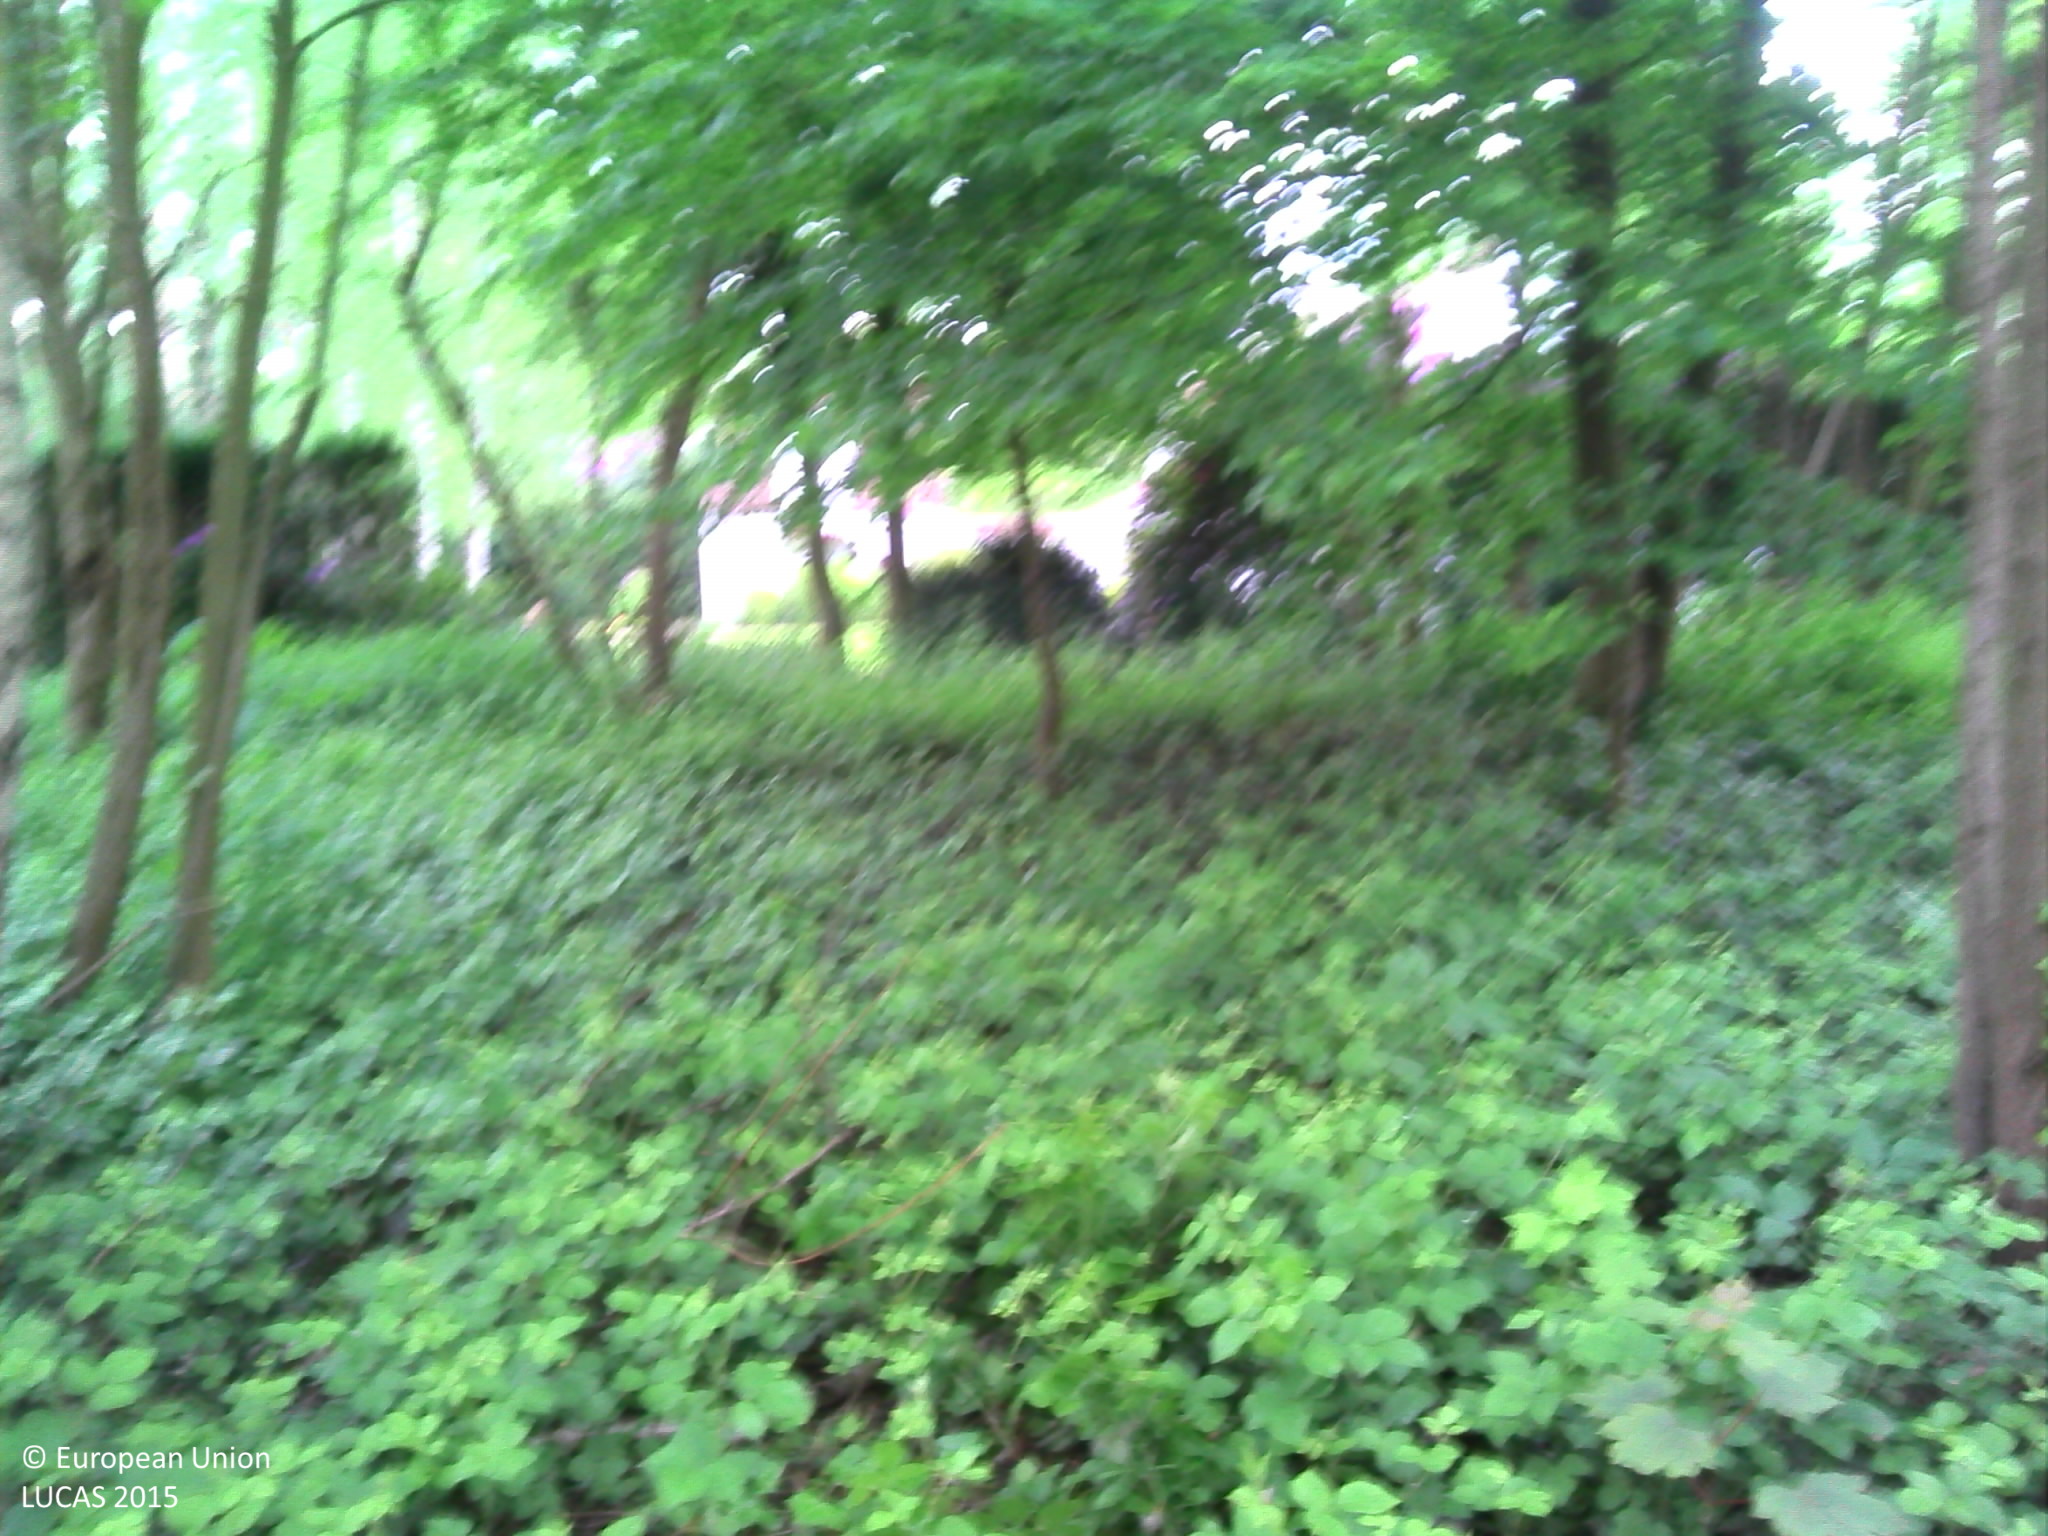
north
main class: Woodland
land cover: Broadleaved woodland
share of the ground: > 75 %
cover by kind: broadleaved forest trees 100 %
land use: Forestry
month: May
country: BE
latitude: 50.6984
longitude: 4.4599
